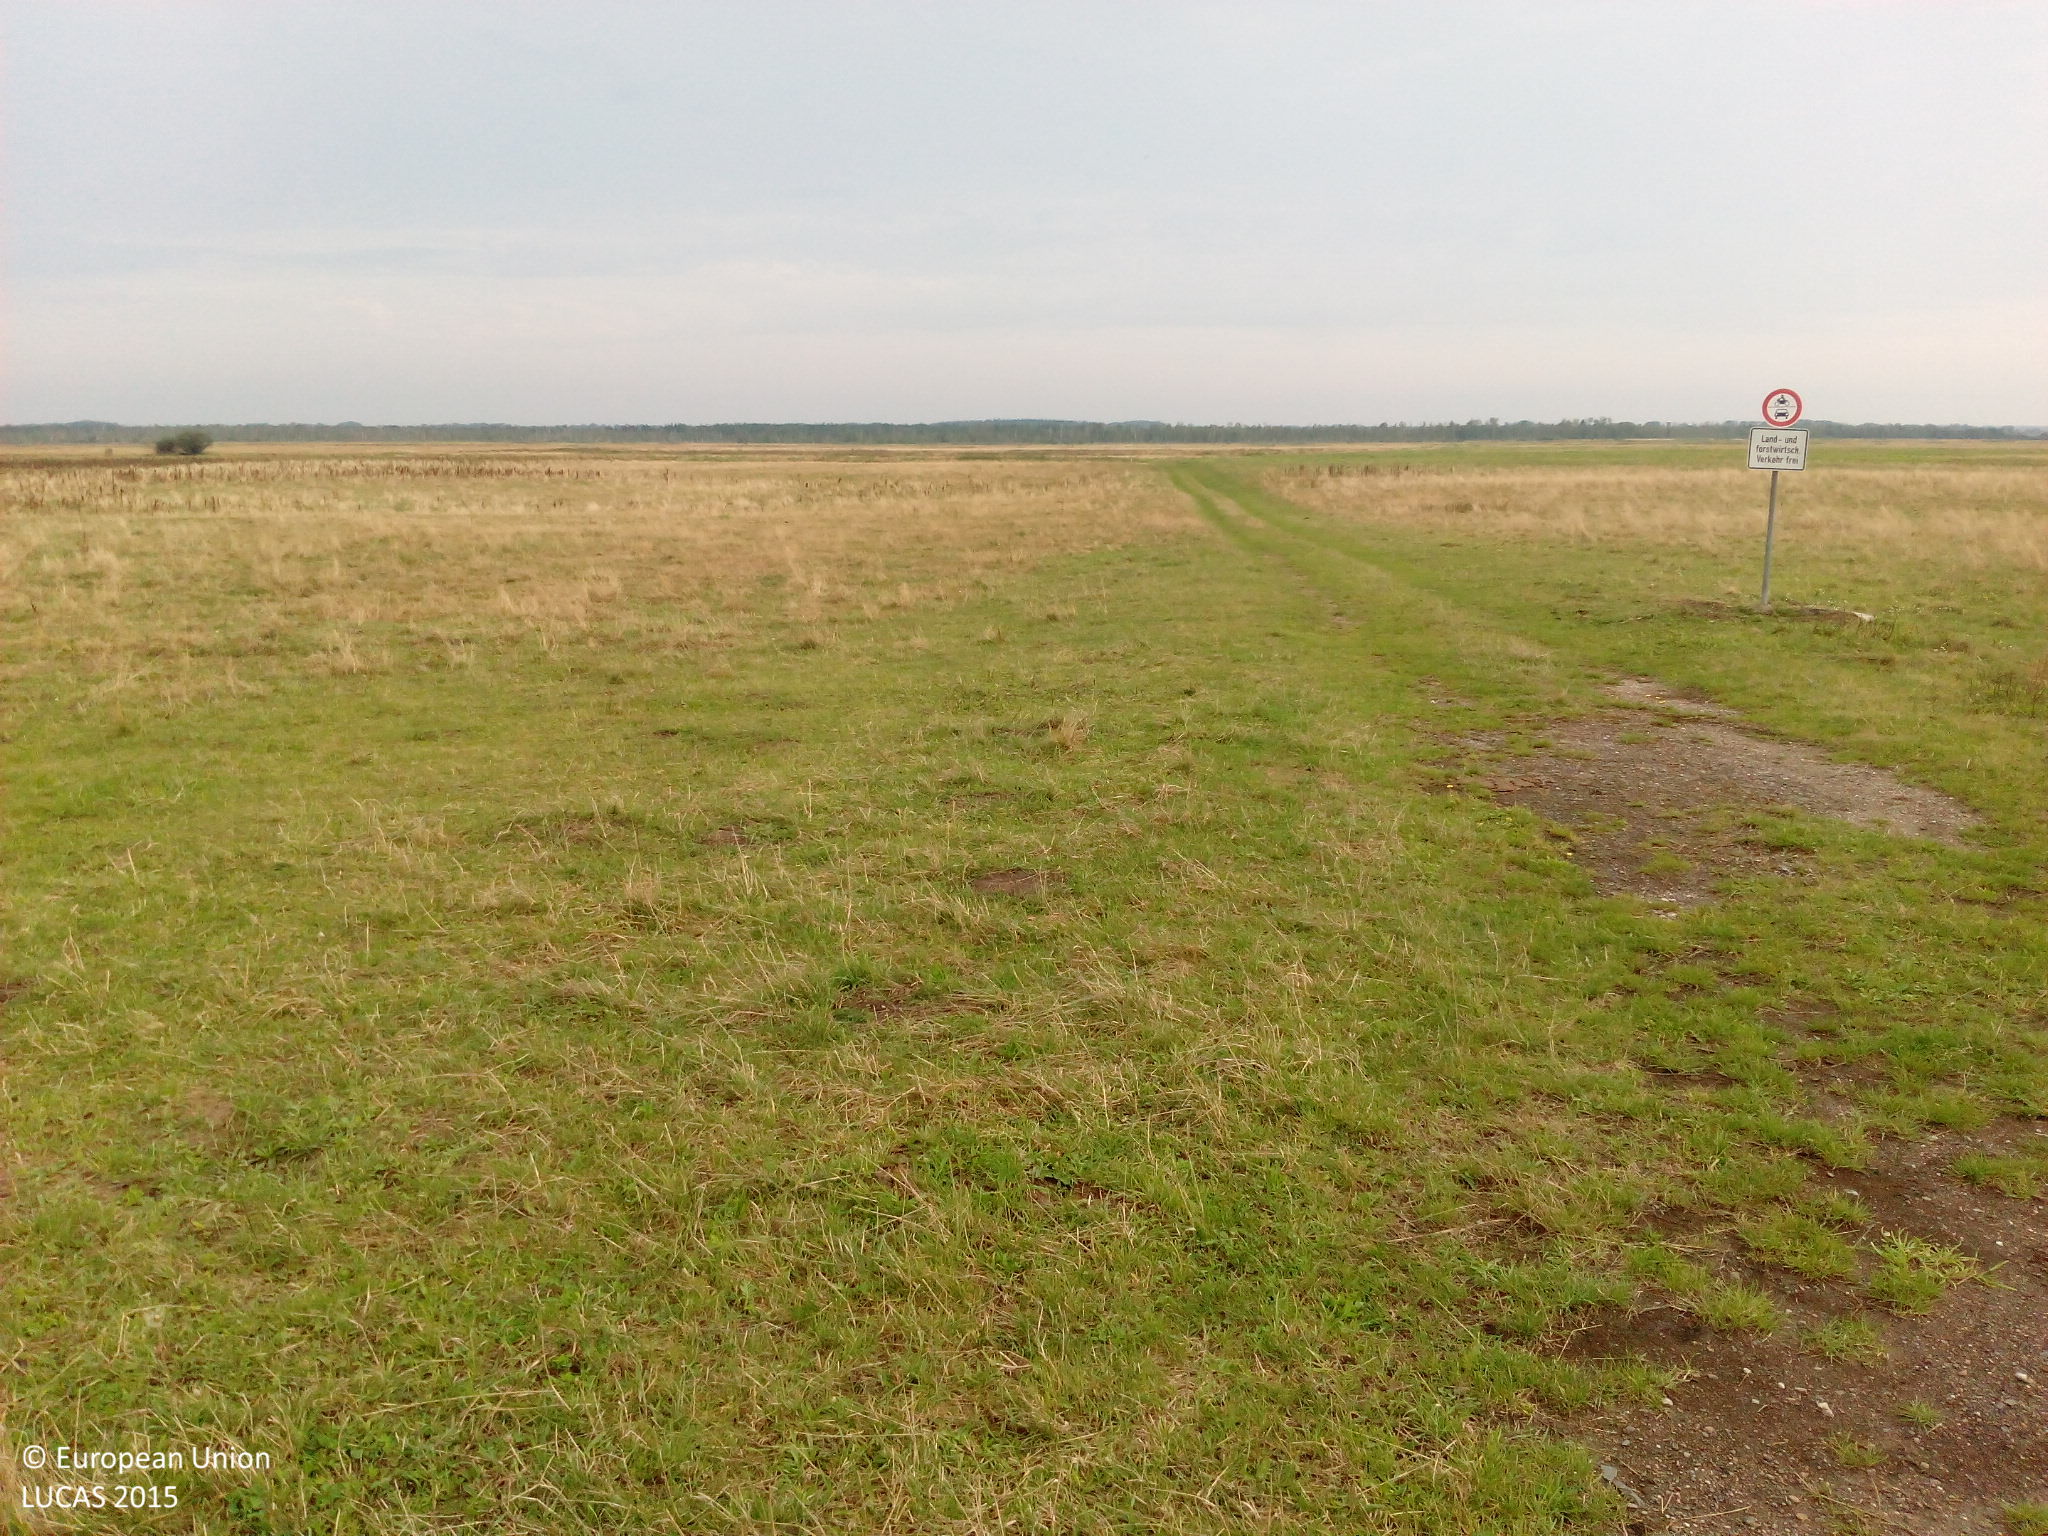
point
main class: Grassland
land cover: Spontaneously vegetated surfaces
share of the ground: > 75 %
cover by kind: herbaceous plants 100 %
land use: Semi-natural and natural areas not in use
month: August
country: DE
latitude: 54.0911
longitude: 12.7052
